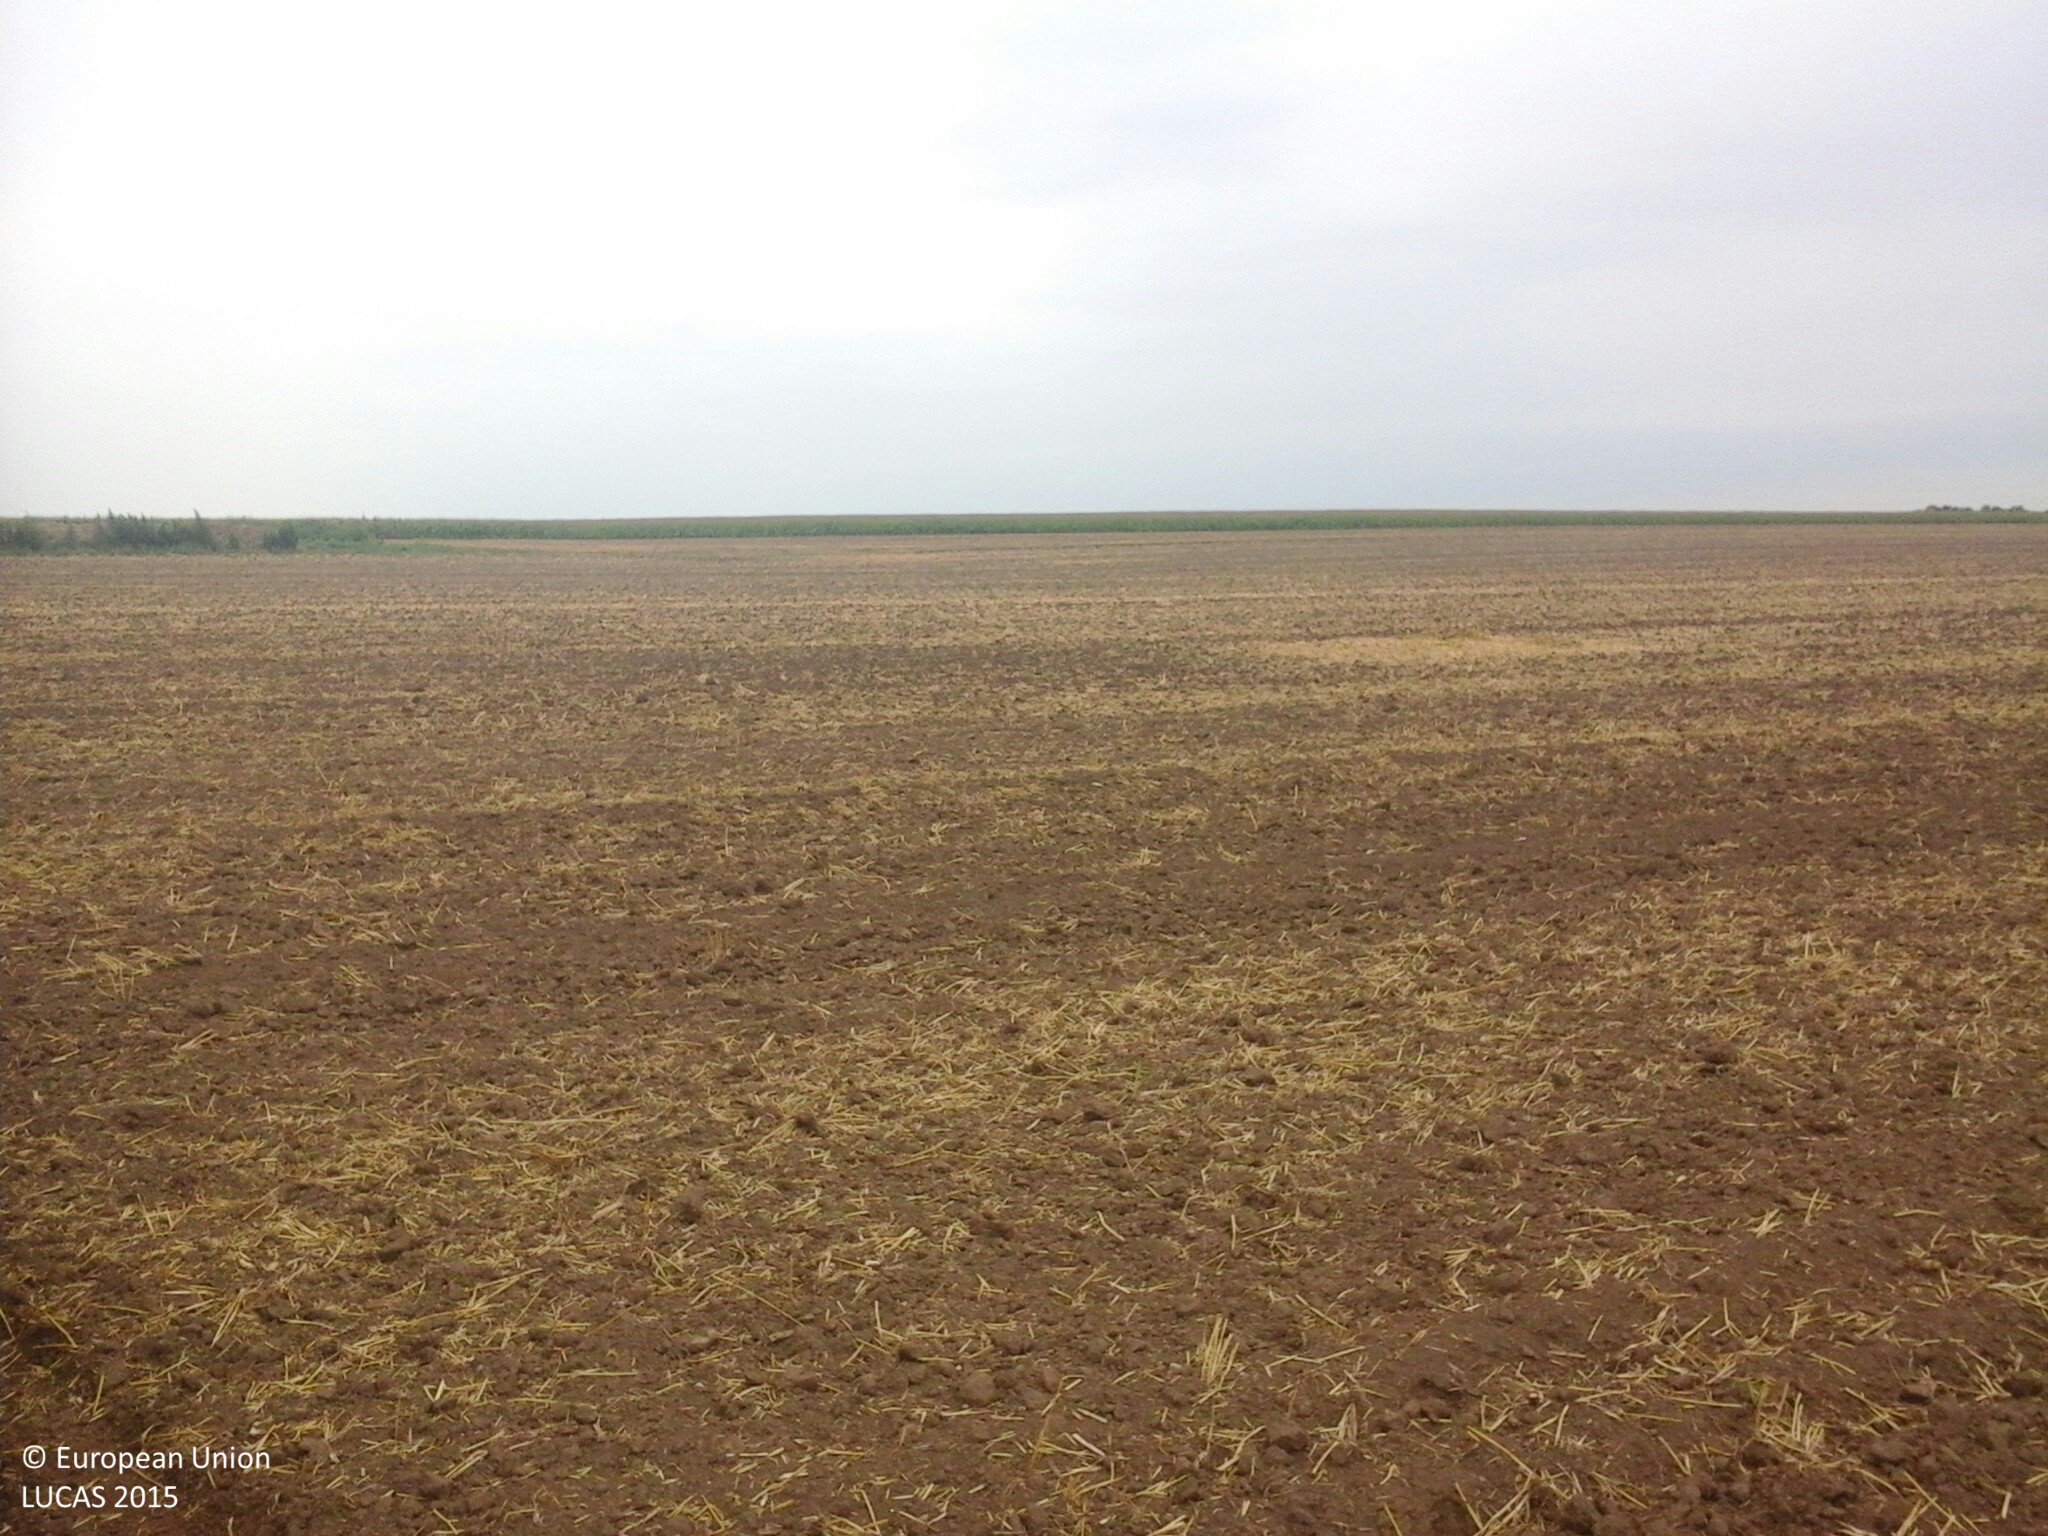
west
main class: Cropland
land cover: Common wheat
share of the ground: < 10 %
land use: Agriculture (excluding fallow land and kitchen gardens)
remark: Harvested field
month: July
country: HU
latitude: 47.0166
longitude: 18.3914
